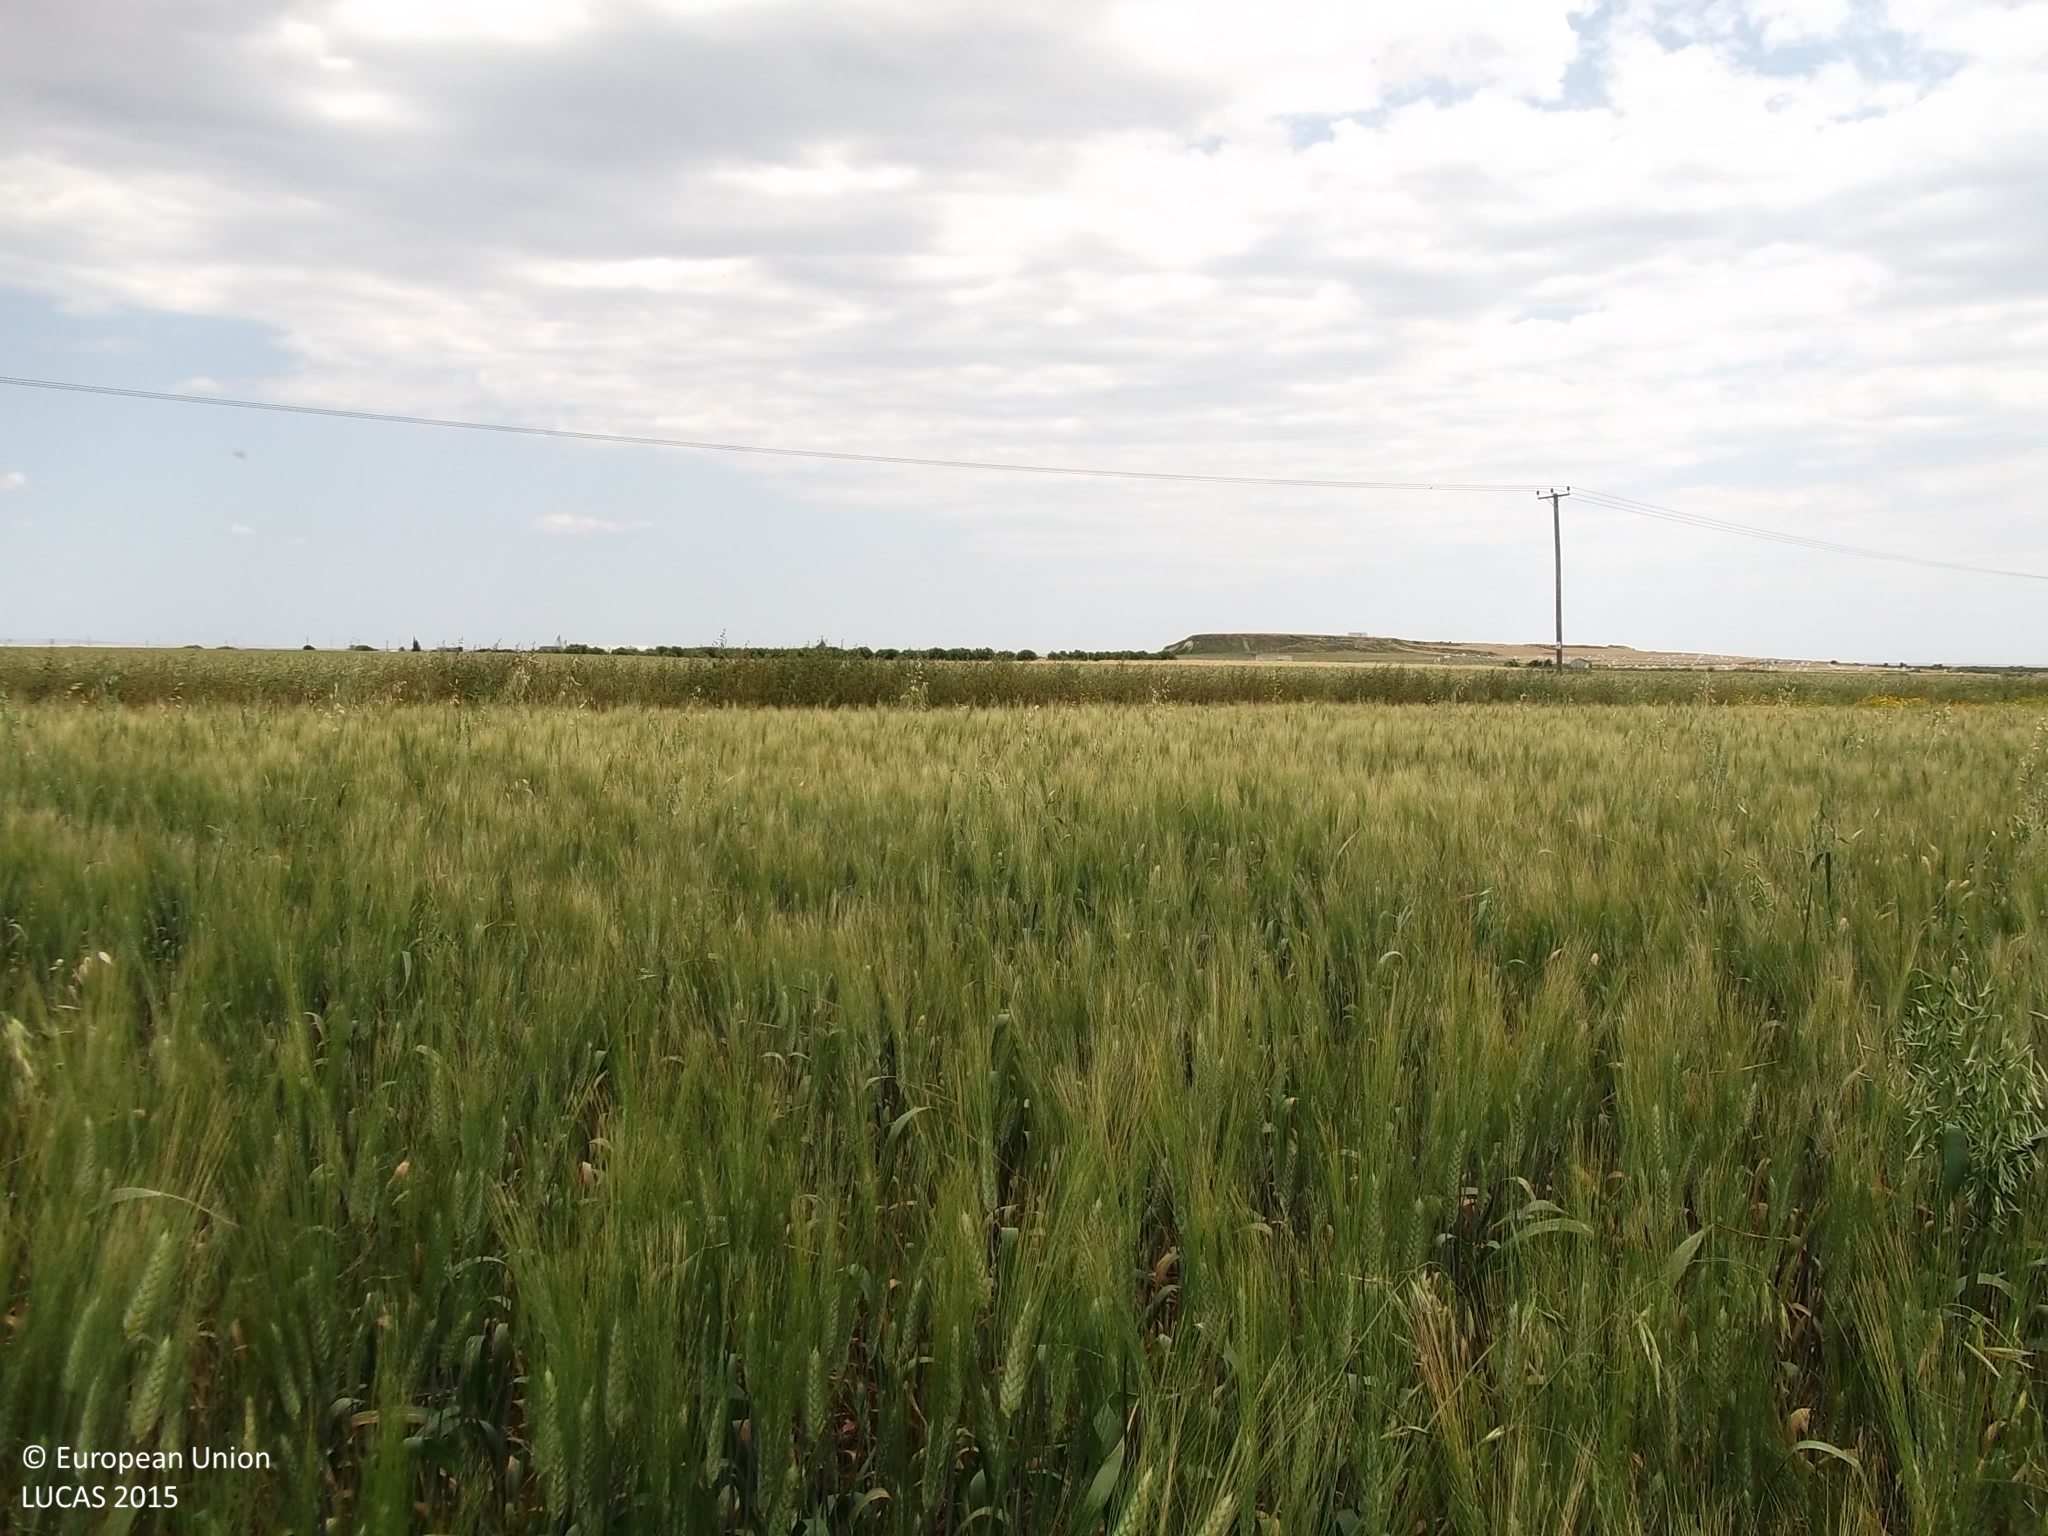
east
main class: Cropland
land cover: Barley
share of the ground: > 75 %
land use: Agriculture (excluding fallow land and kitchen gardens)
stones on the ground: < 10 %
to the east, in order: Barley; Paved roads, cycling and walking lanes; Grass margins; Common wheat; Electric lines; Common wheat; Barley
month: April
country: CY
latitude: 34.8769
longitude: 33.5495
